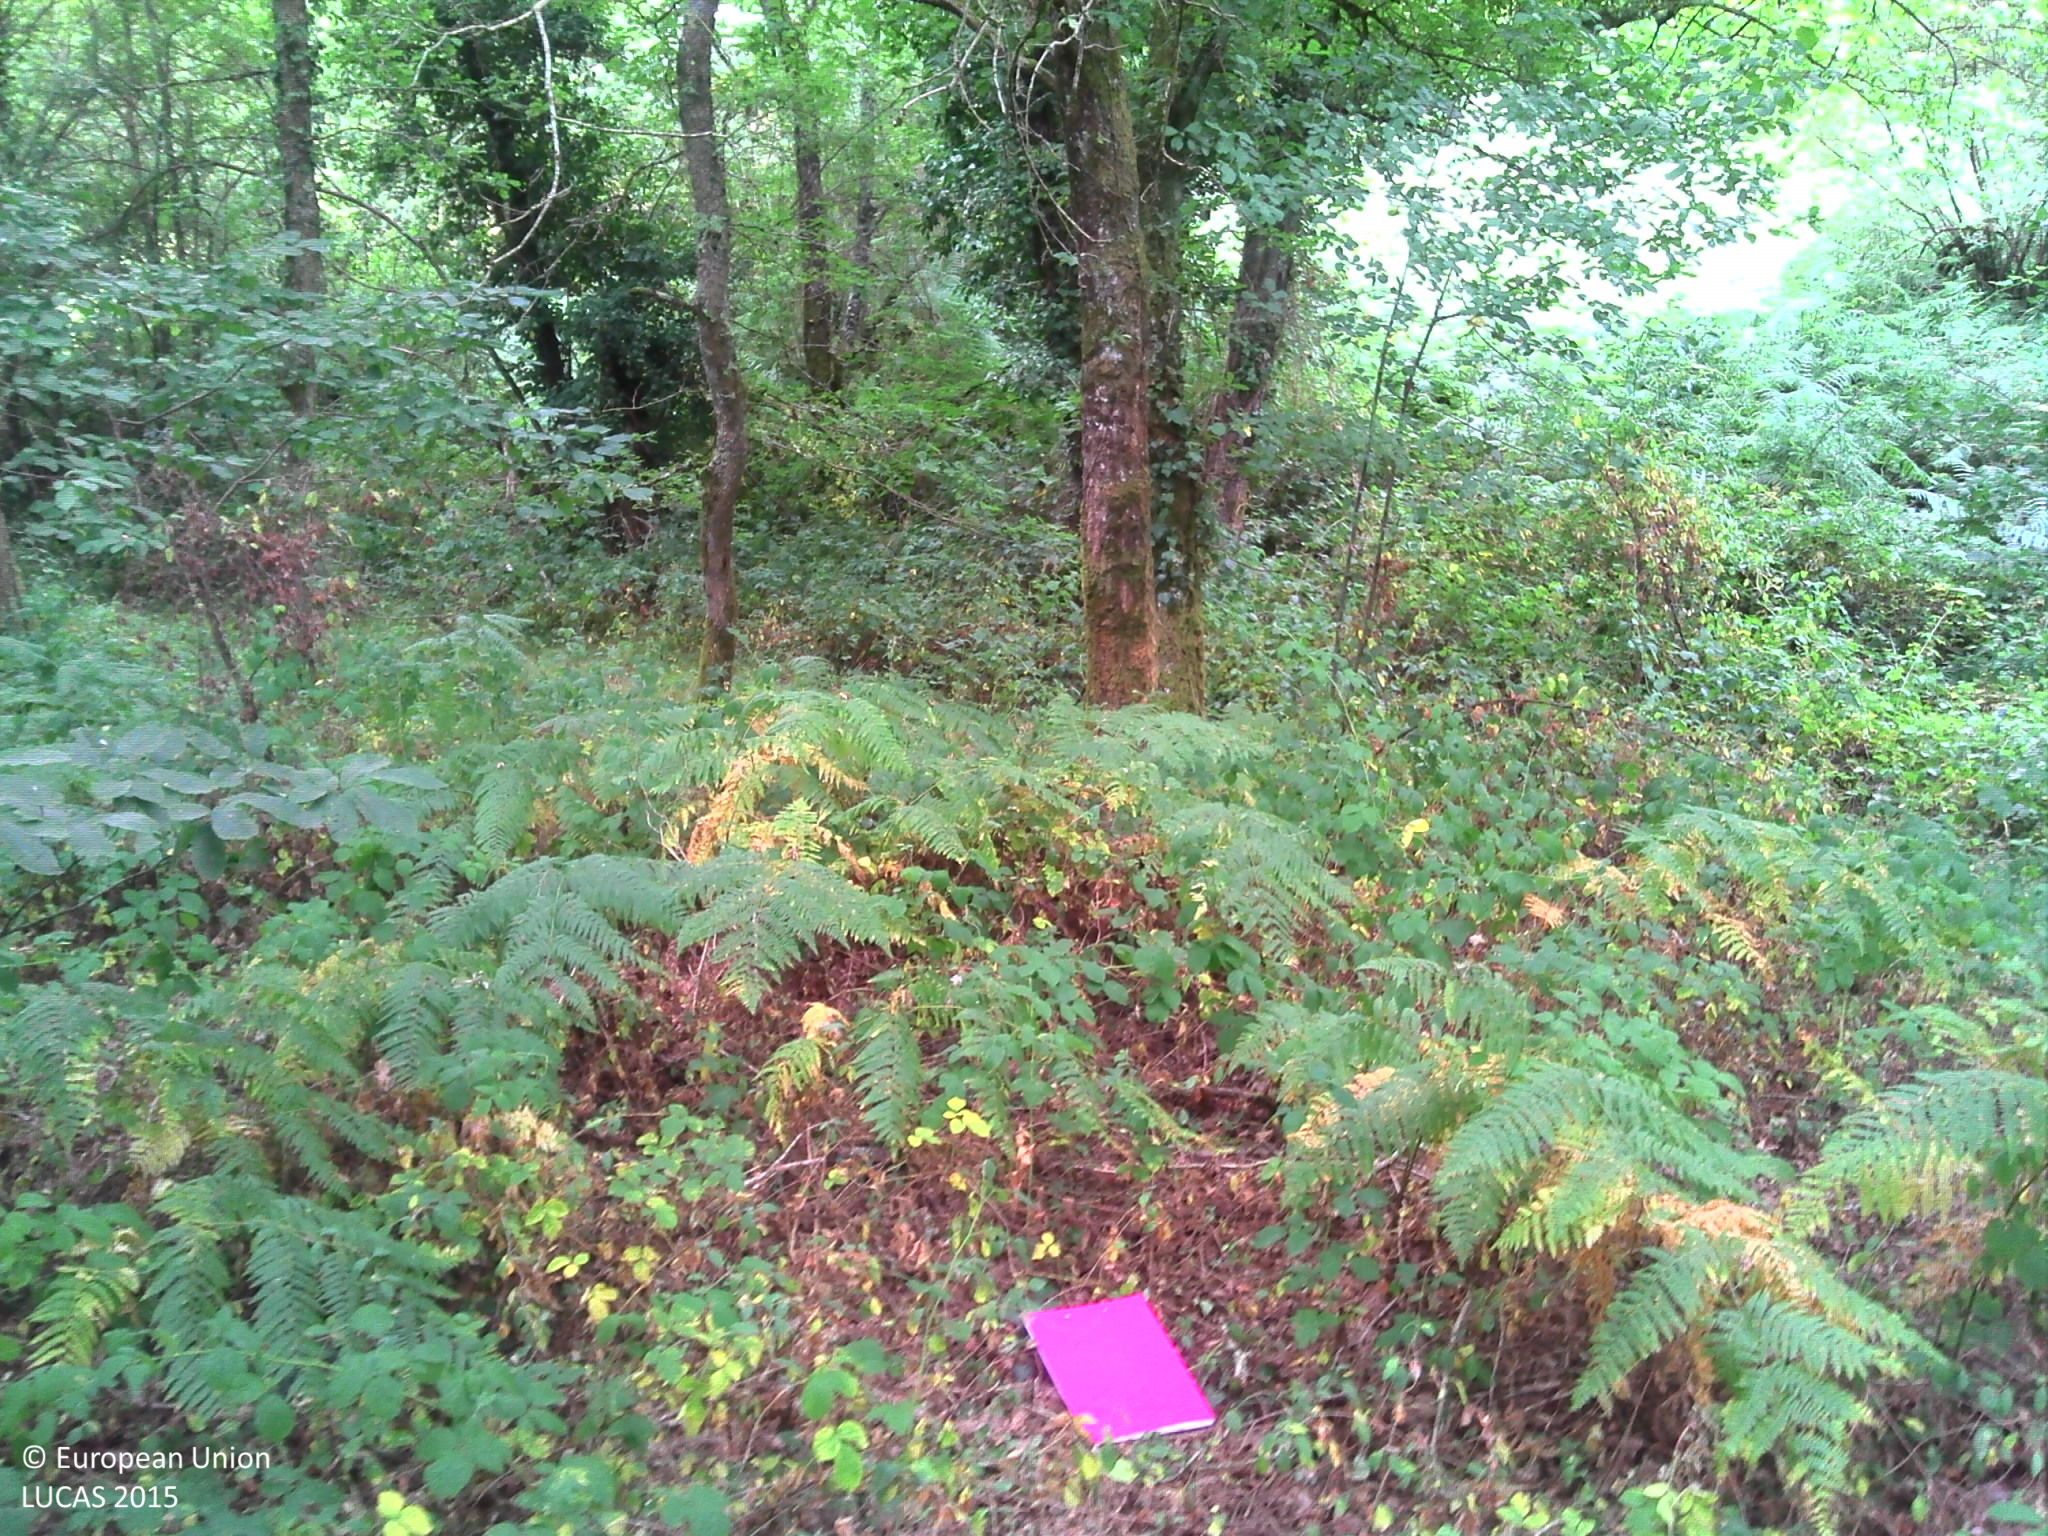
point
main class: Woodland
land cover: Broadleaved woodland
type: mesophytic deciduous forest
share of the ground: > 75 %
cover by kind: broadleaved forest trees 85 %, herbaceous plants 10 %, shrubs 5 %
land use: Forestry
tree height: > 5 m
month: July
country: FR
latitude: 46.4006
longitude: 1.6014
